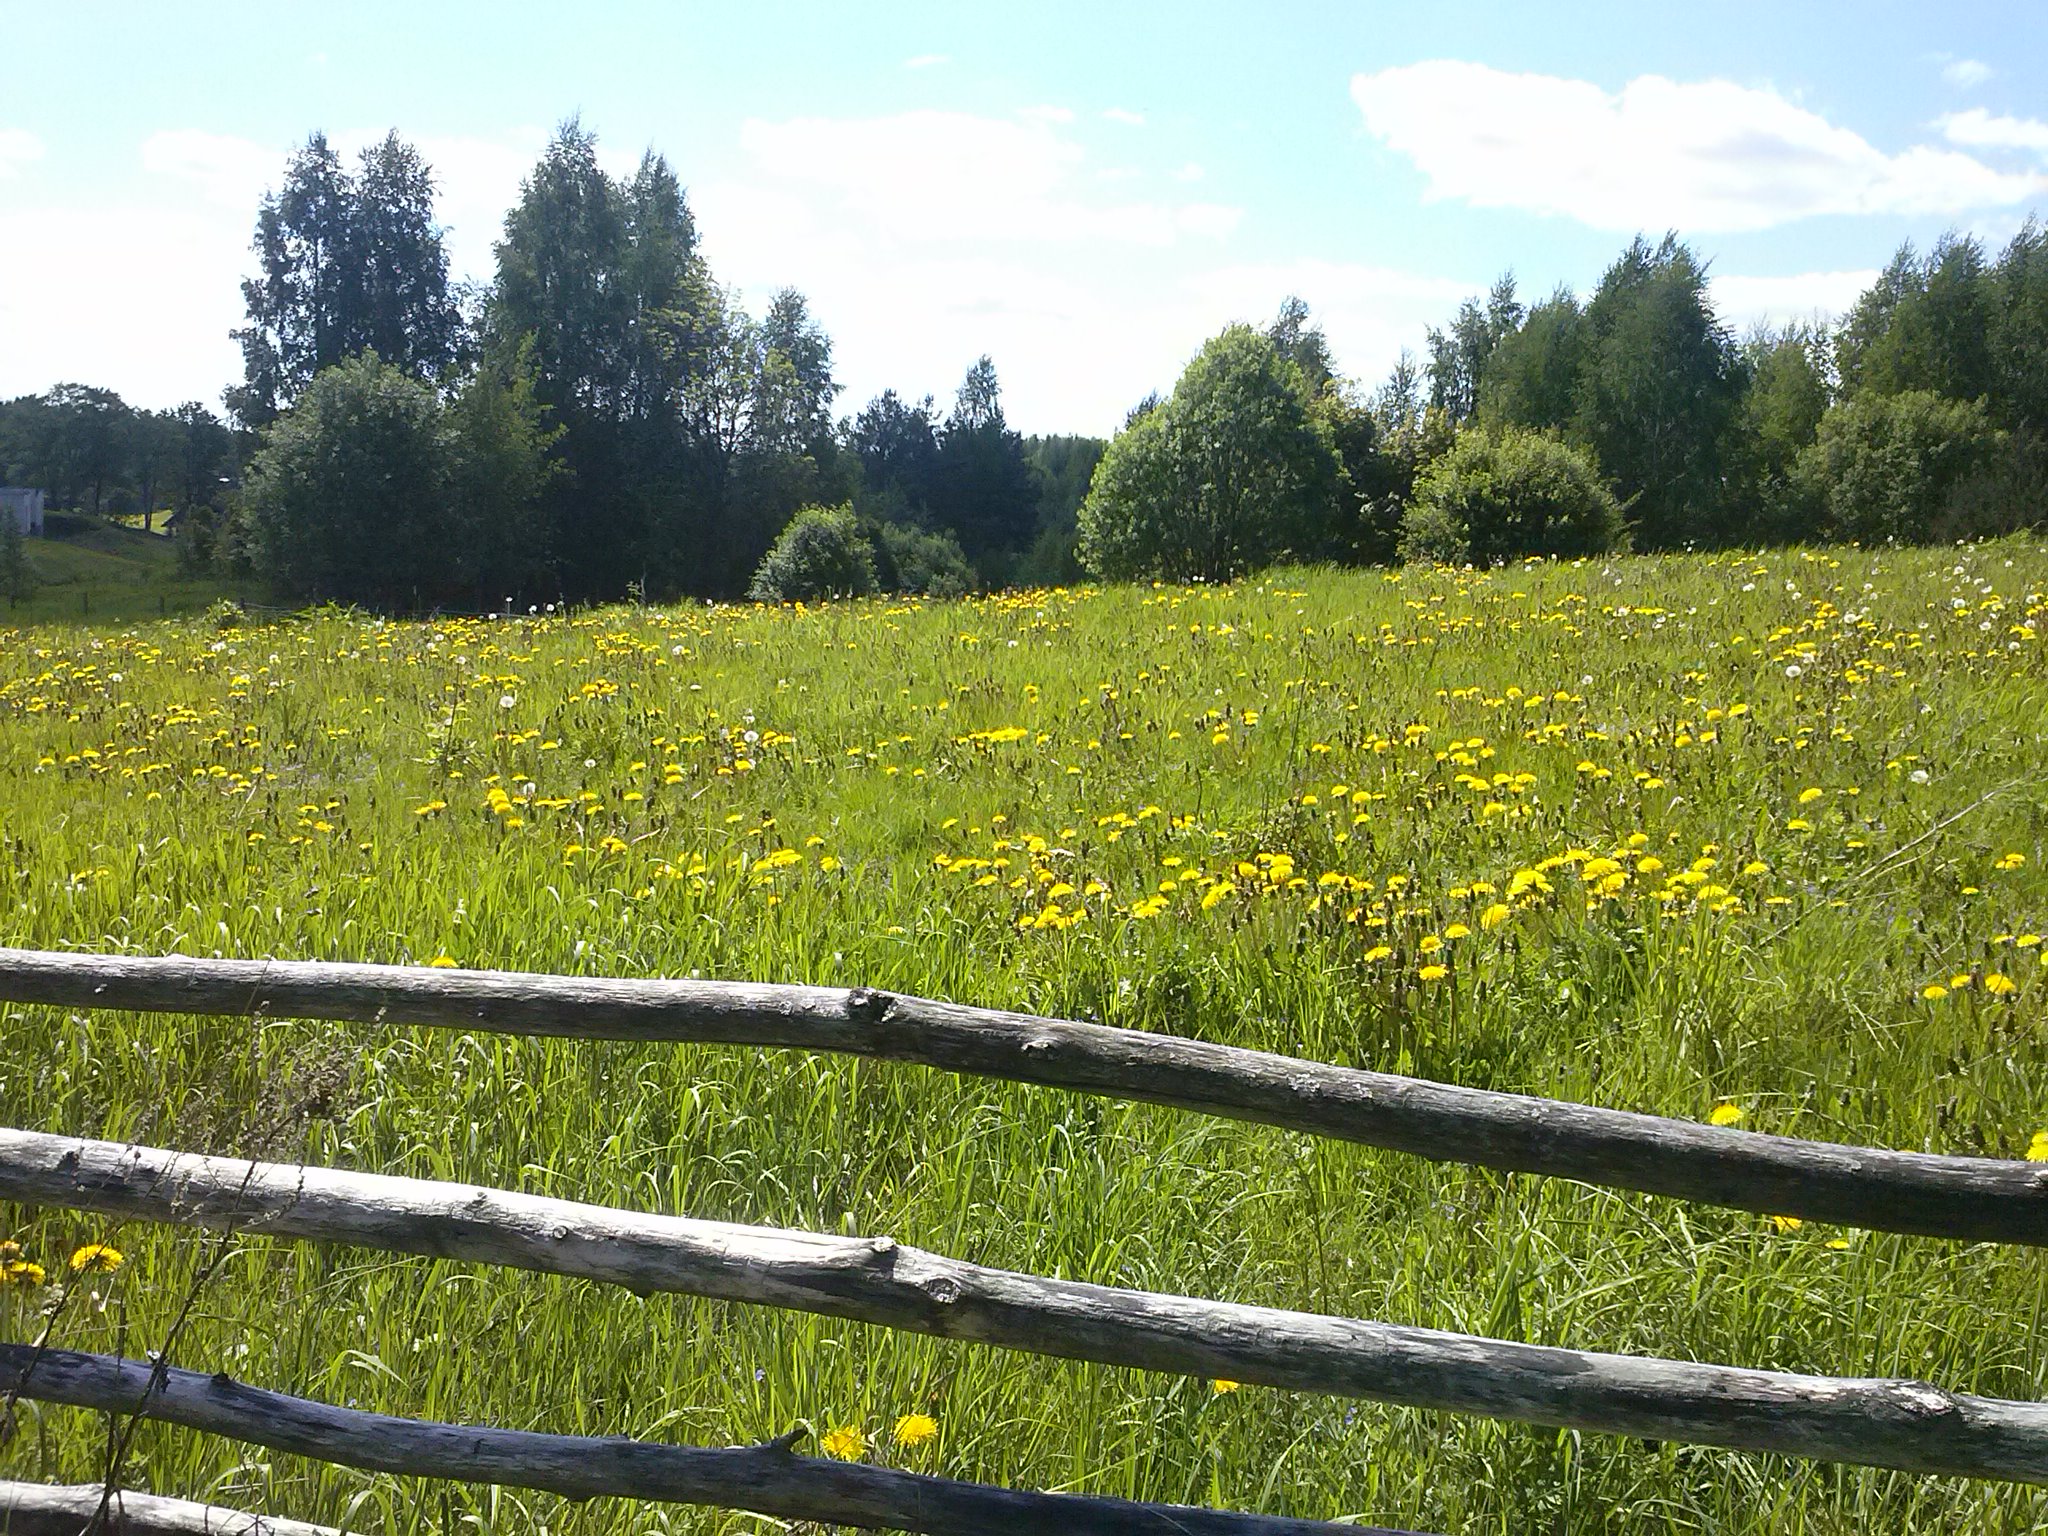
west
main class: Grassland
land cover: Grassland without tree/shrub cover
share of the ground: > 75 %
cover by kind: herbaceous plants 100 %
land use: Agriculture (excluding fallow land and kitchen gardens)
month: May
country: LV
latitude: 56.1969
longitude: 27.5733
